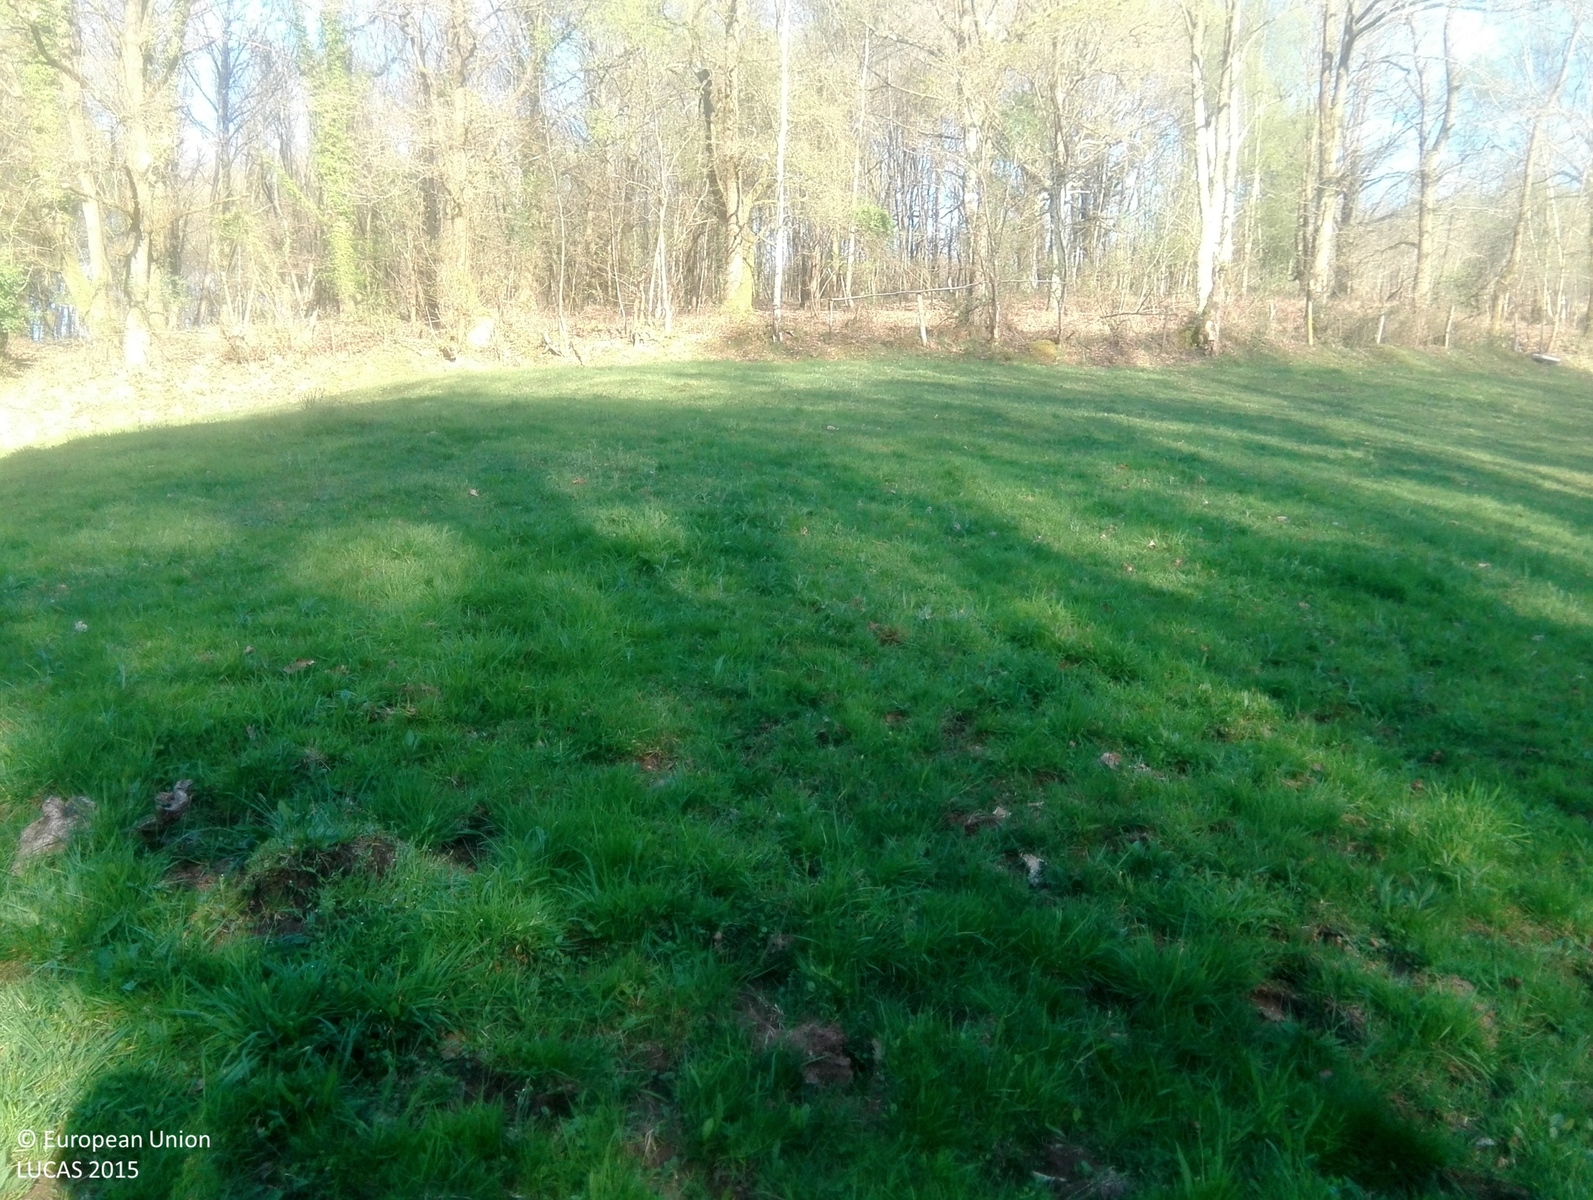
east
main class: Grassland
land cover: Grassland without tree/shrub cover
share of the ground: > 75 %
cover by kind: herbaceous plants 100 %
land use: Agriculture (excluding fallow land and kitchen gardens)
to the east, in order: Grassland without tree/shrub cover; Fences; Tracks; Broadleaved woodland; Tracks; Fences; Broadleaved woodland
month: April
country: ES
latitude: 43.3787
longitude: -5.6225
